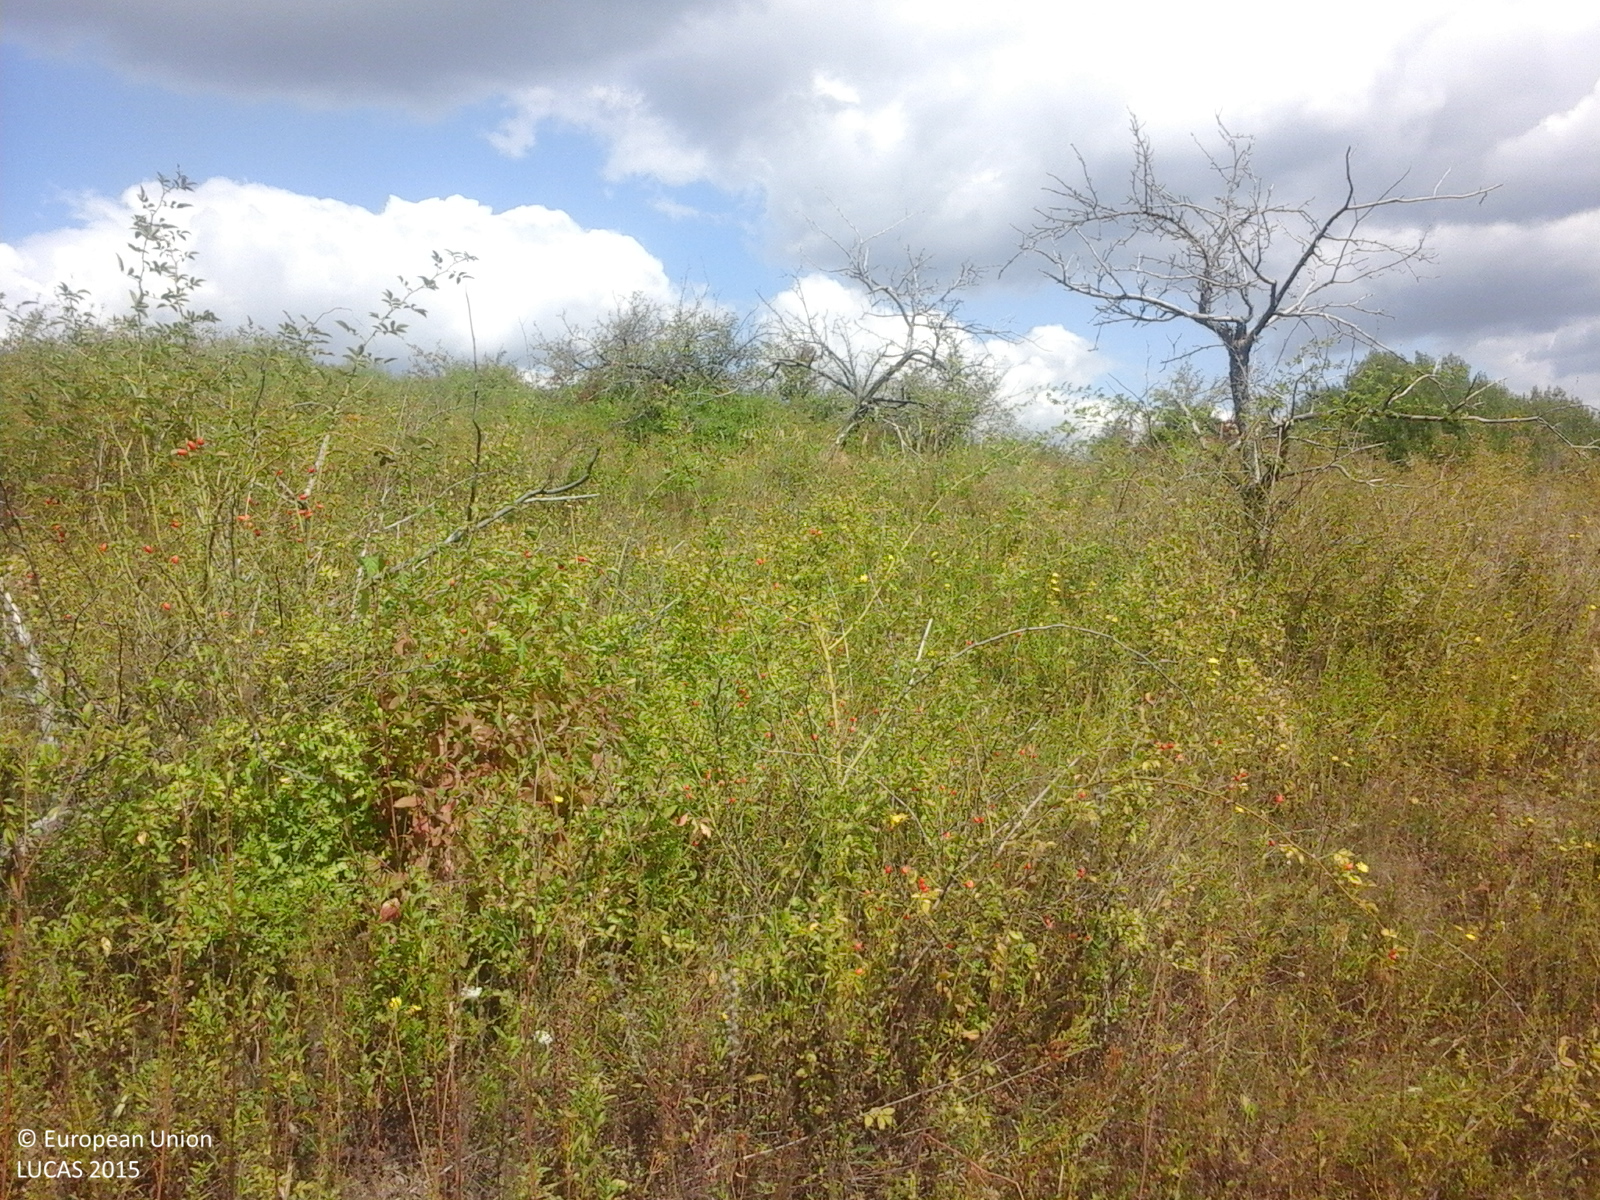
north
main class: Grassland
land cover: Spontaneously vegetated surfaces
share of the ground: > 75 %
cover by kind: herbaceous plants 100 %
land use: Fallow land
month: September
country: RO
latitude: 47.4585
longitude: 23.0789
